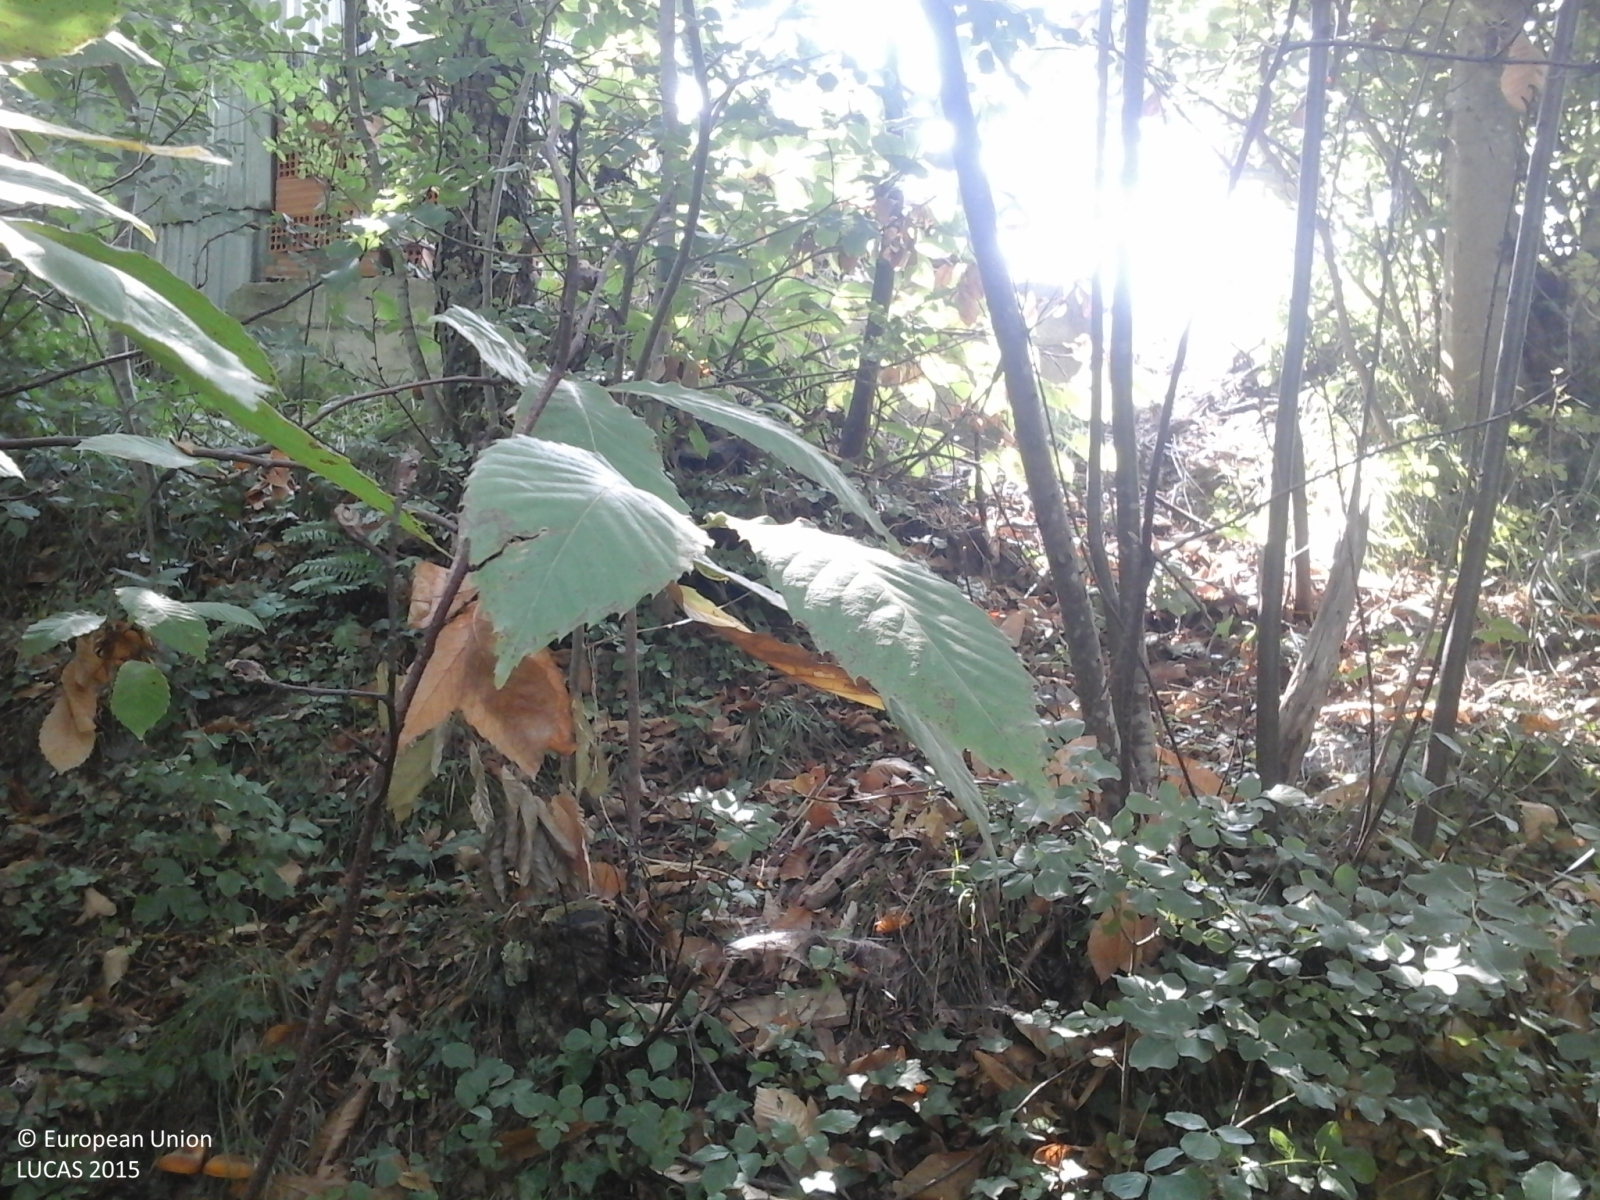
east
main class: Woodland
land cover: Broadleaved woodland
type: mesophytic deciduous forest
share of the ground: > 75 %
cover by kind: broadleaved forest trees 100 %
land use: Forestry
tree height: > 5 m
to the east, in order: Broadleaved woodland; Arable land (only in case pi); Grass margins; Paved roads, cycling and walking lanes; Electric lines; Broadleaved woodland; Artificial constructions in urban areas
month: September
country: IT
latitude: 44.4552
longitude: 9.1348
